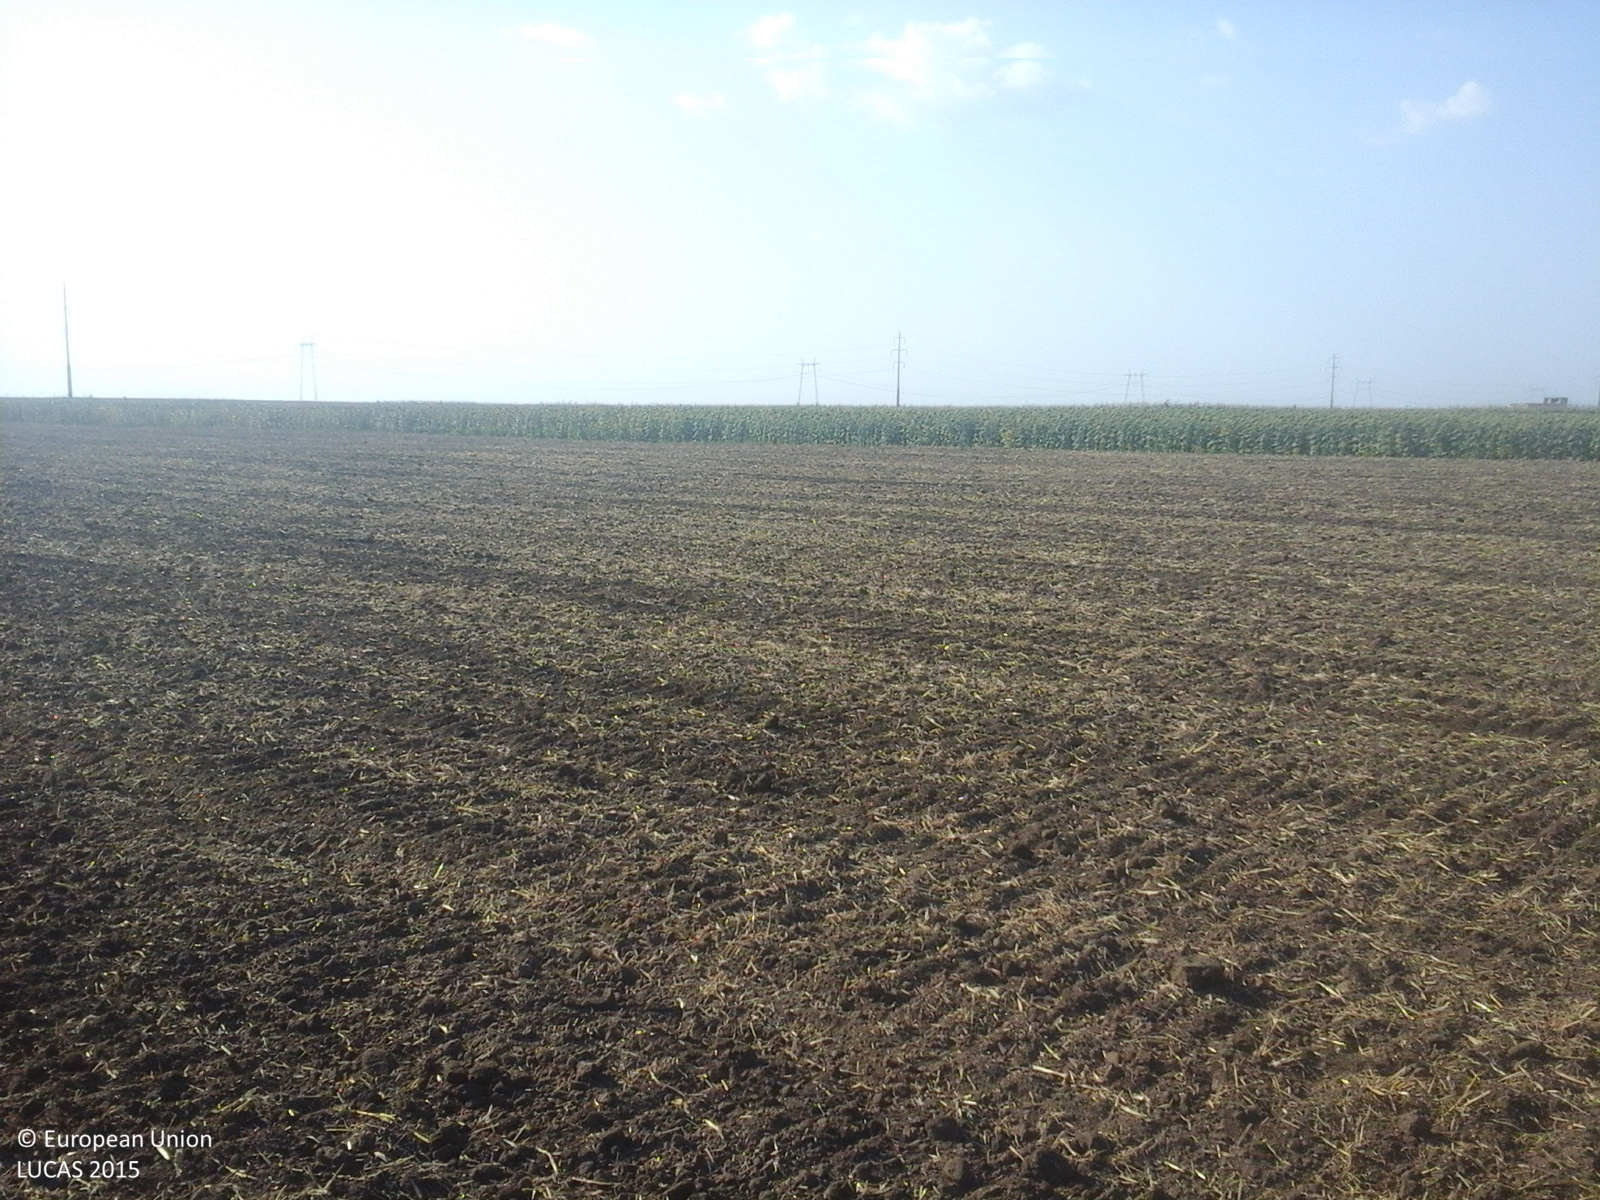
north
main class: Cropland
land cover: Sunflower
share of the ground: > 75 %
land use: Agriculture (excluding fallow land and kitchen gardens)
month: July
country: RO
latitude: 44.9461
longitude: 27.7336
